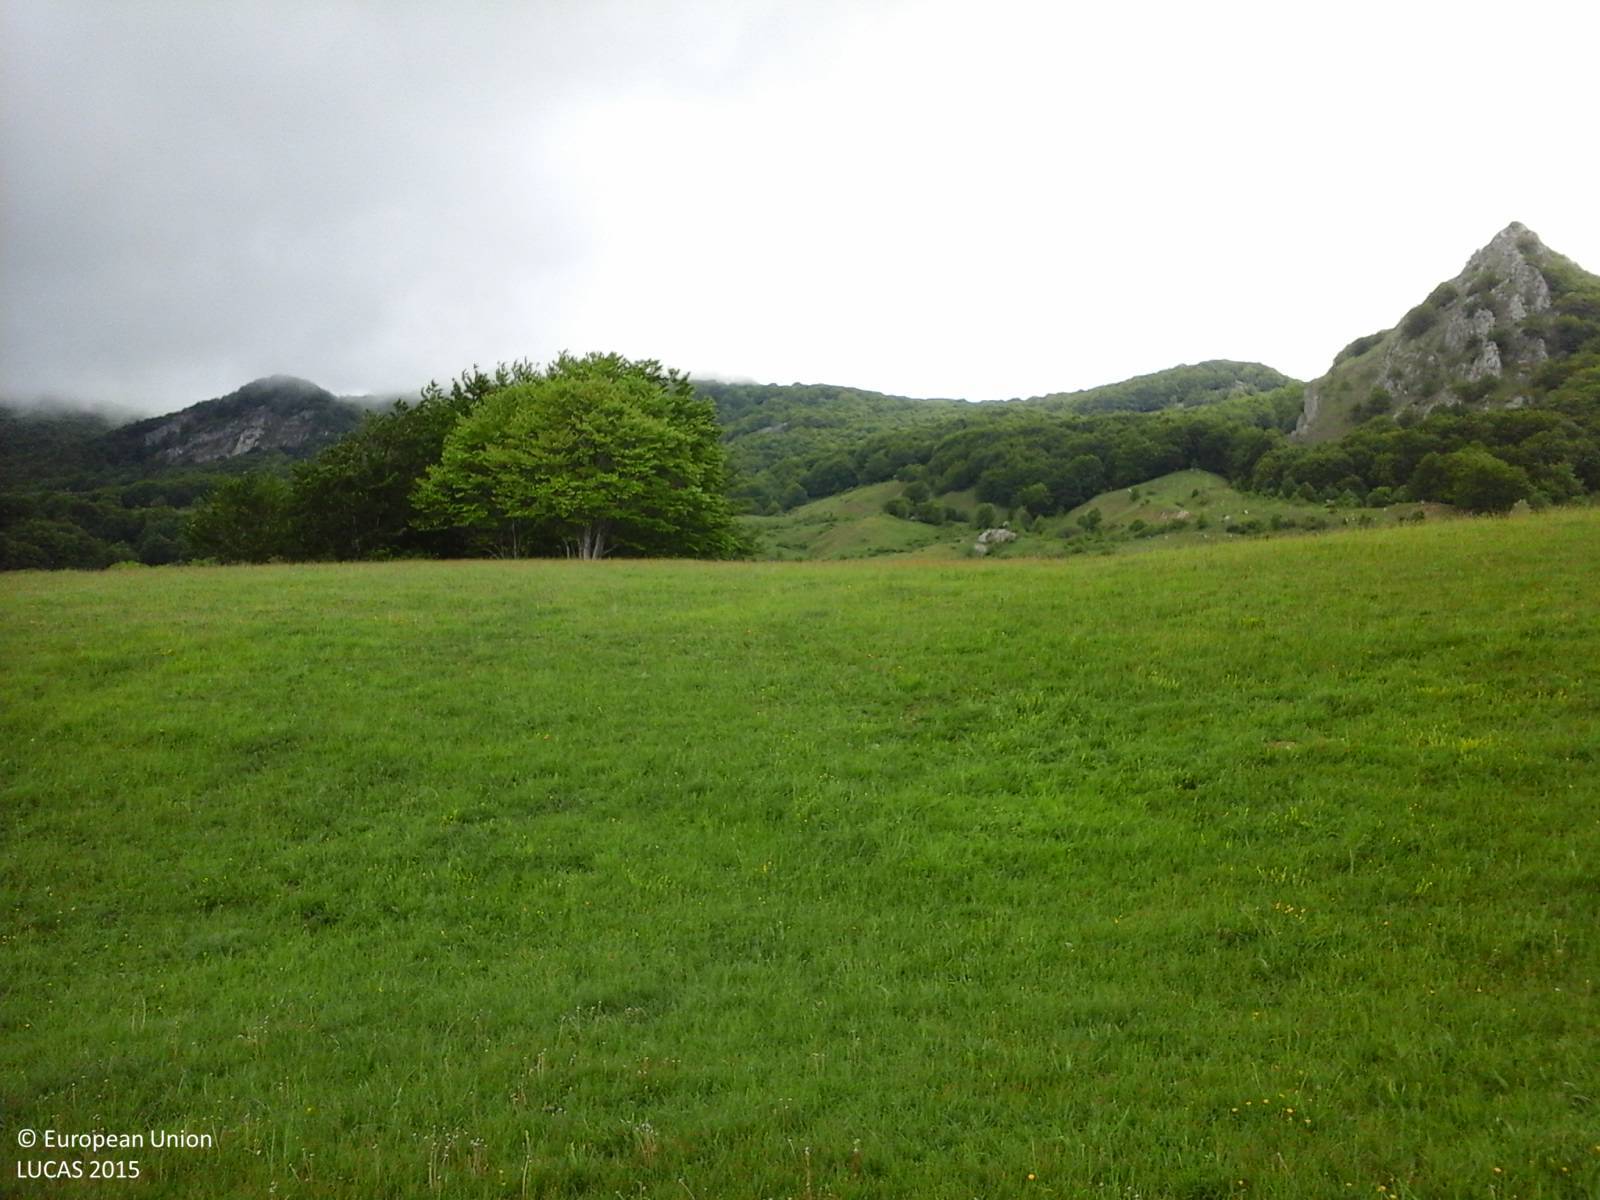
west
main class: Grassland
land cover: Grassland without tree/shrub cover
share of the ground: > 75 %
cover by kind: herbaceous plants 100 %
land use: Agriculture (excluding fallow land and kitchen gardens)
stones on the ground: < 10 %
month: May
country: IT
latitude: 41.8980
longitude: 14.1926
